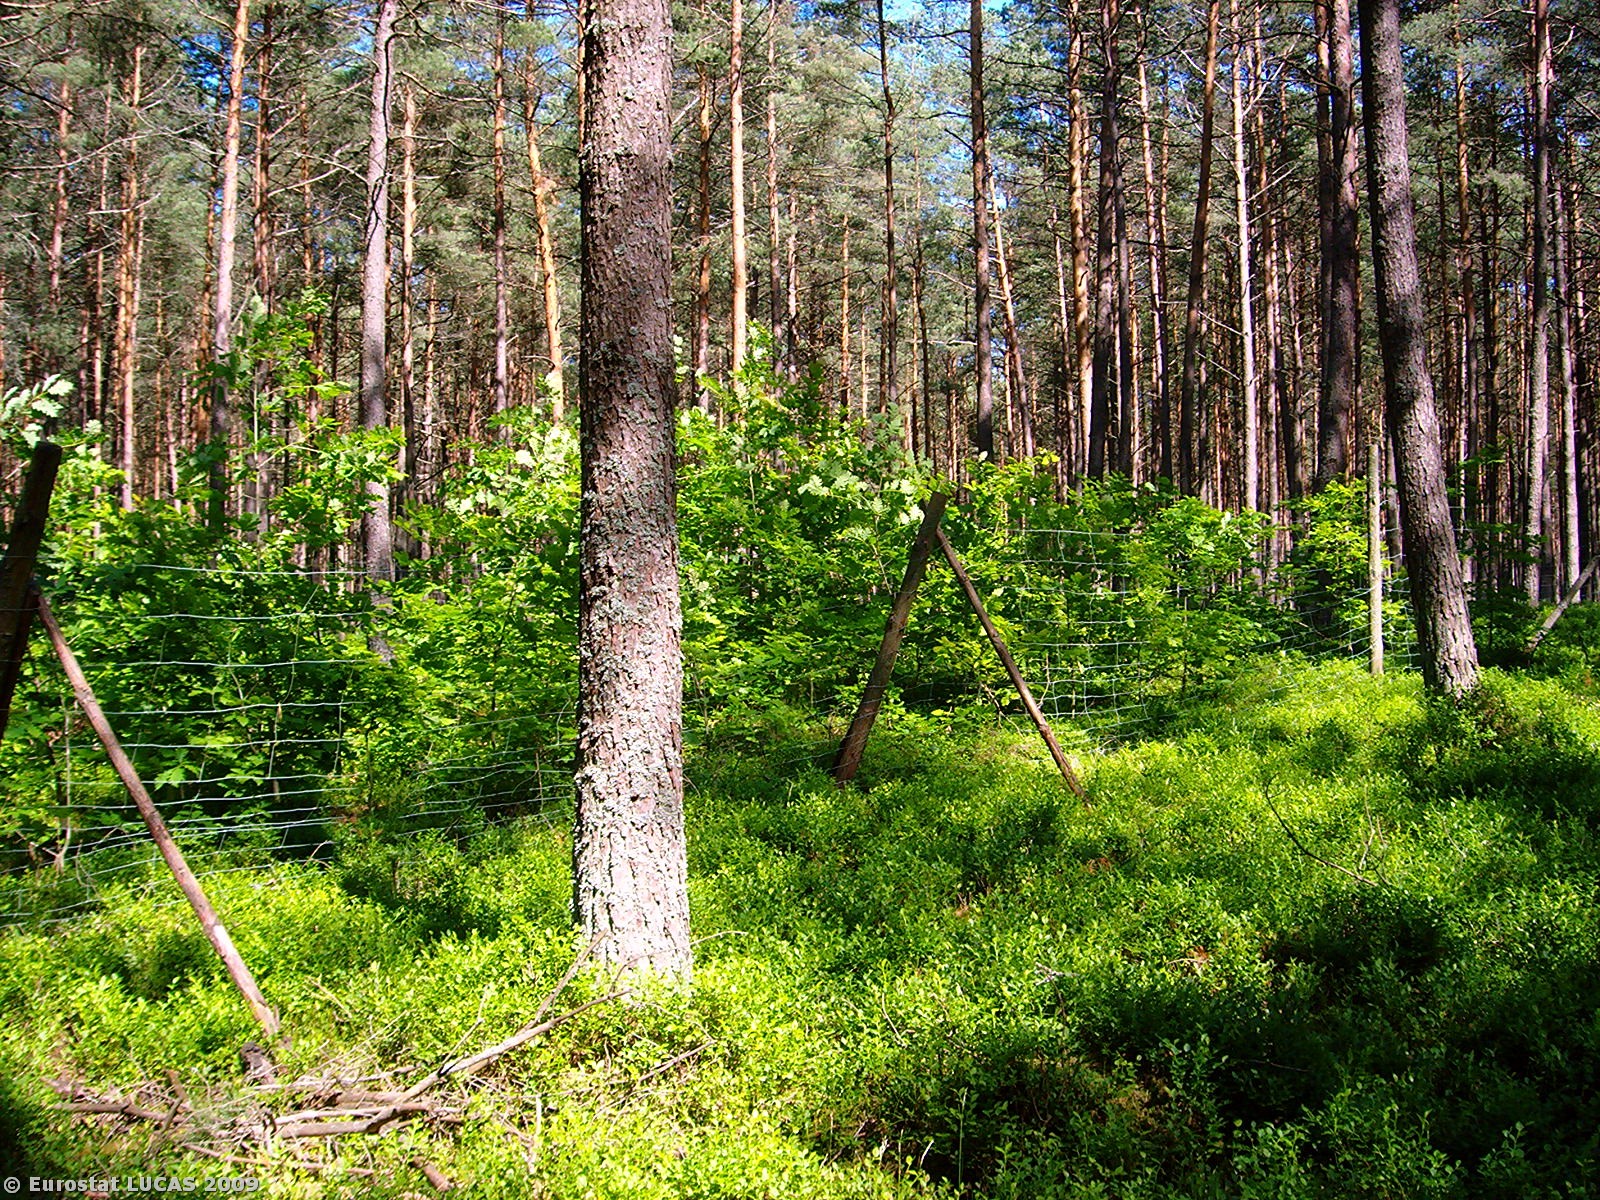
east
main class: Woodland
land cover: Coniferous woodland
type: hemiboreal forest and nemoral coniferous forest and mixed broadleaved-coniferous forest
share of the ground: 50 - 75 %
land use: Forestry
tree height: > 5 m
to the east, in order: Coniferous woodland; Fences; Mixed woodland; Fences; Coniferous woodland; Tracks; Coniferous woodland; Tracks; Coniferous woodland
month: June
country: PL
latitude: 53.9804
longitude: 17.2222
